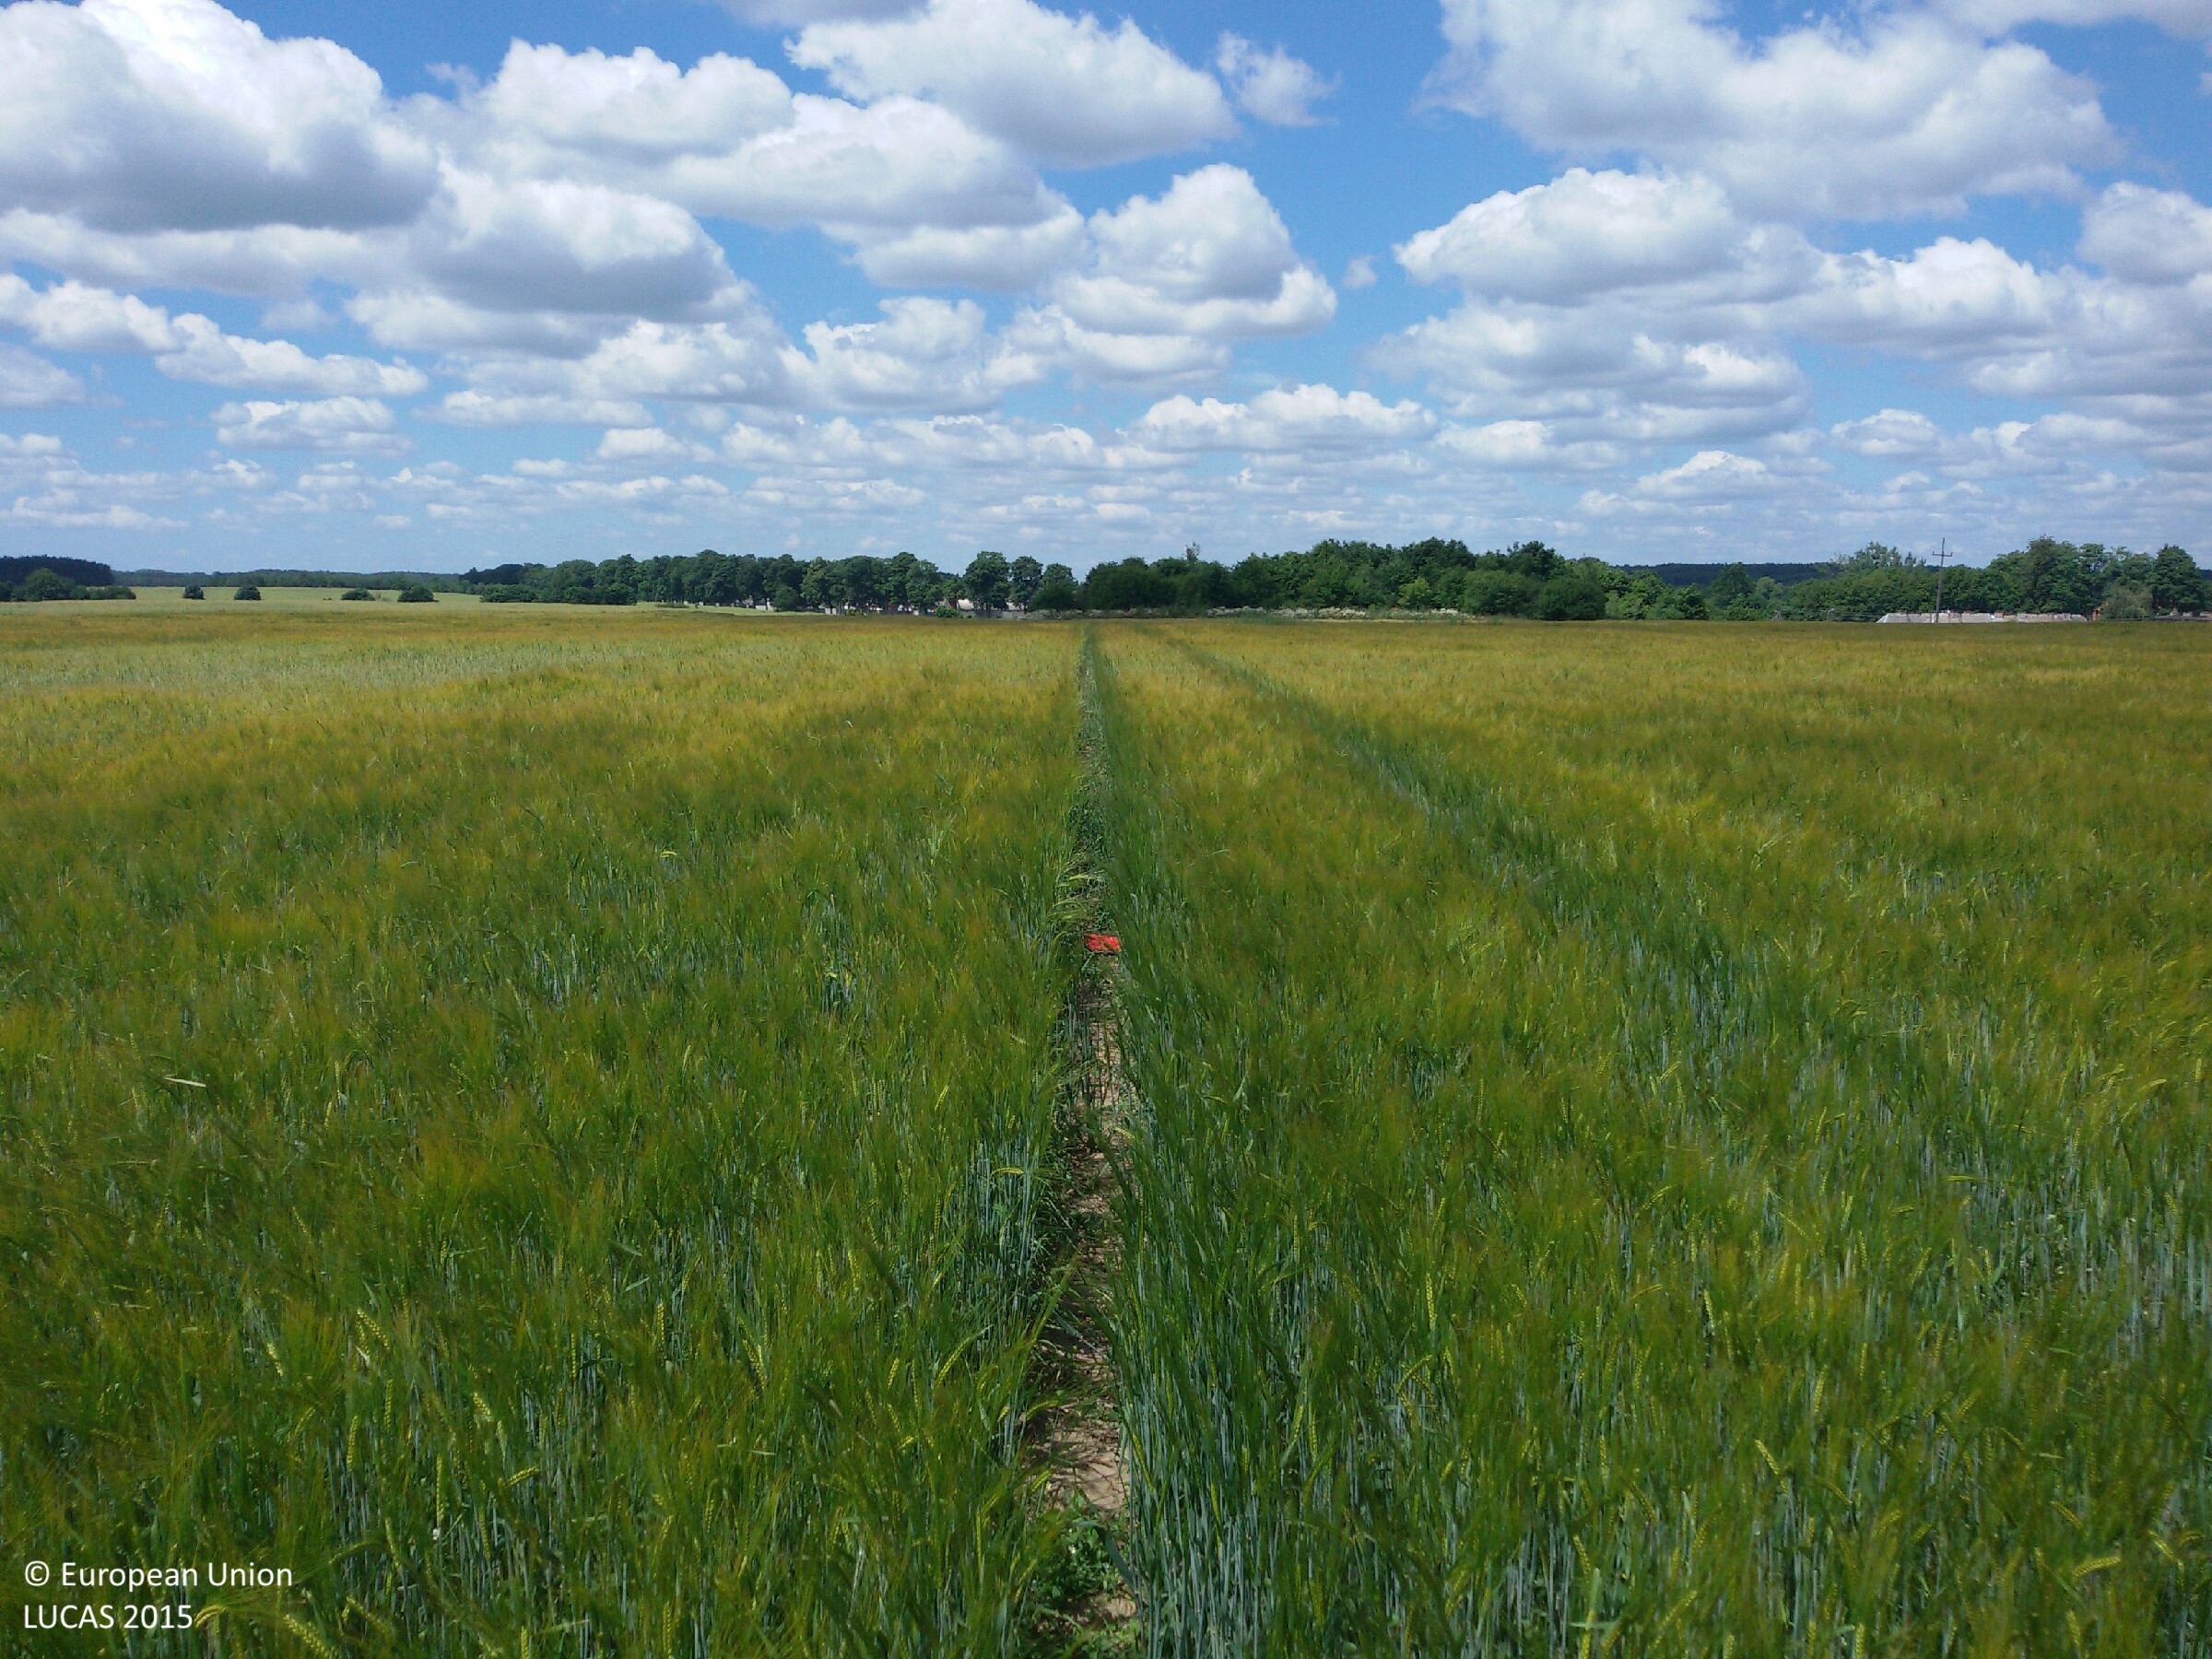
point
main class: Cropland
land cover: Barley
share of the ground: > 75 %
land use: Agriculture (excluding fallow land and kitchen gardens)
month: July
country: PL
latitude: 53.4113
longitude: 20.1277
